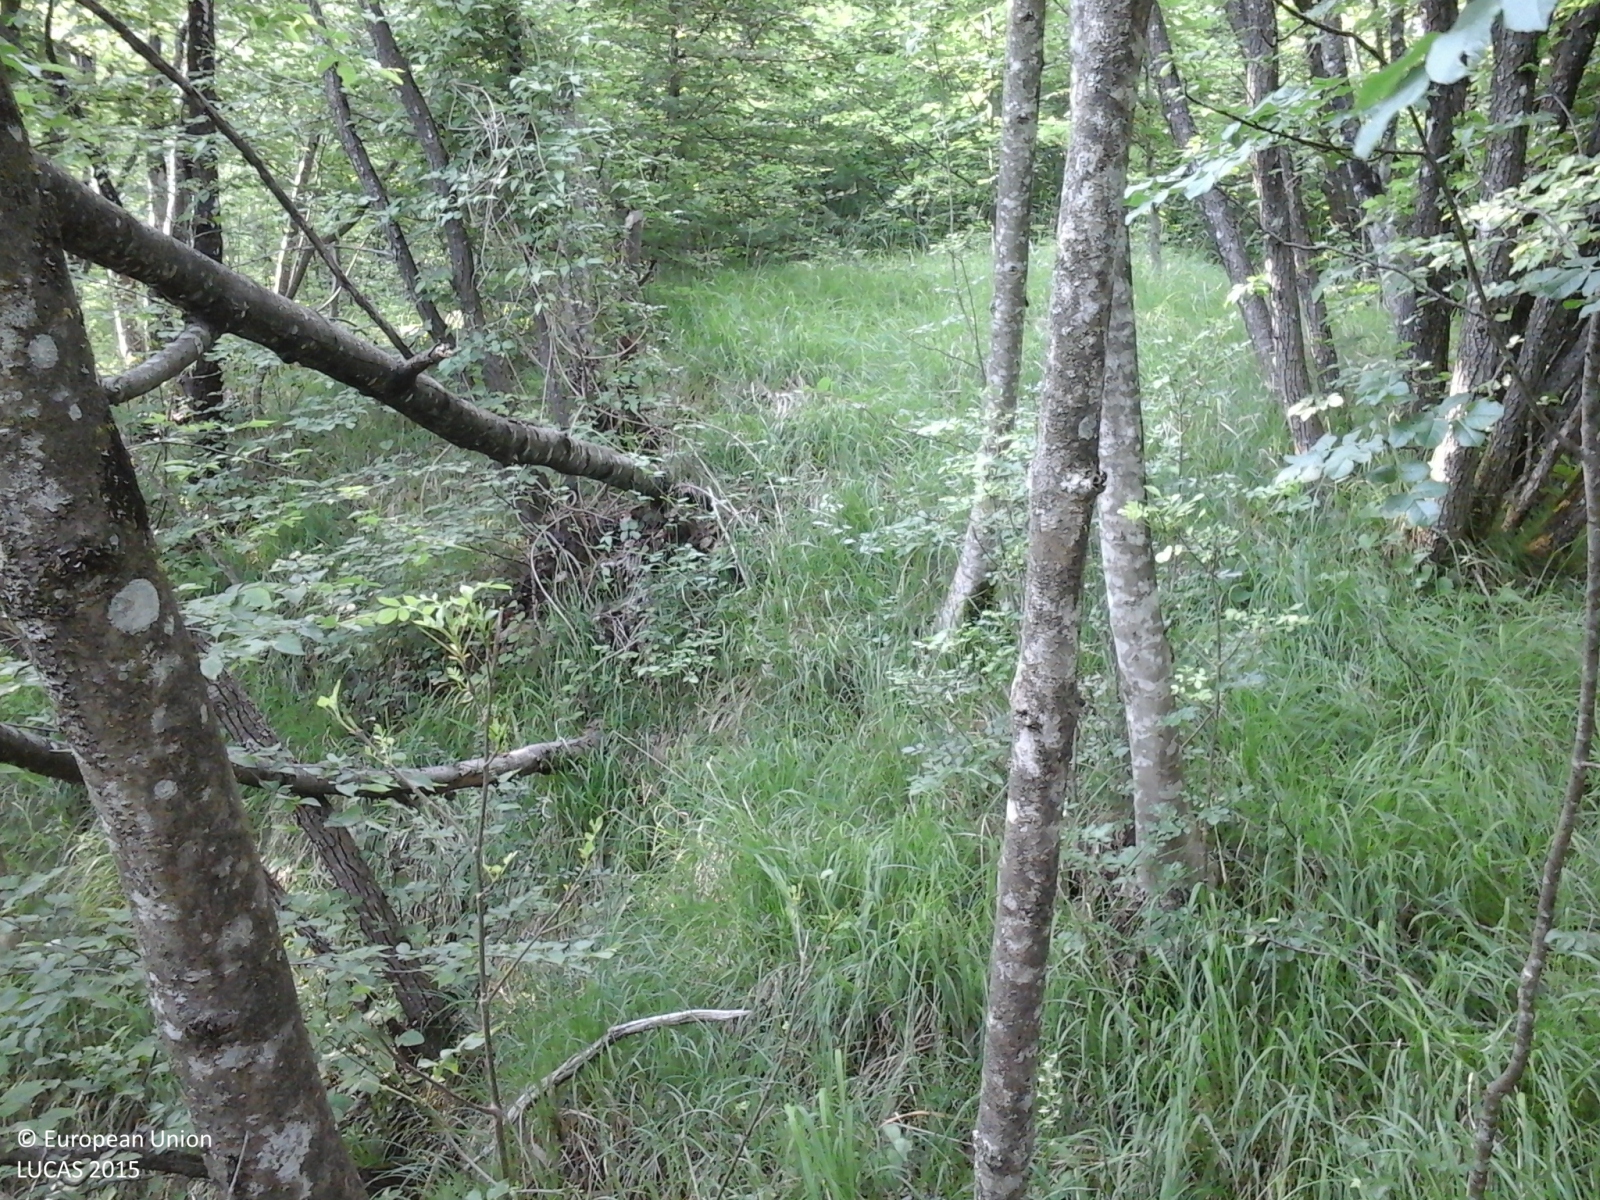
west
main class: Woodland
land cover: Broadleaved woodland
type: thermophilous deciduous forest
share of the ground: > 75 %
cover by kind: broadleaved forest trees 100 %
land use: Semi-natural and natural areas not in use
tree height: > 5 m
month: June
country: IT
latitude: 46.1808
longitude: 12.3678
